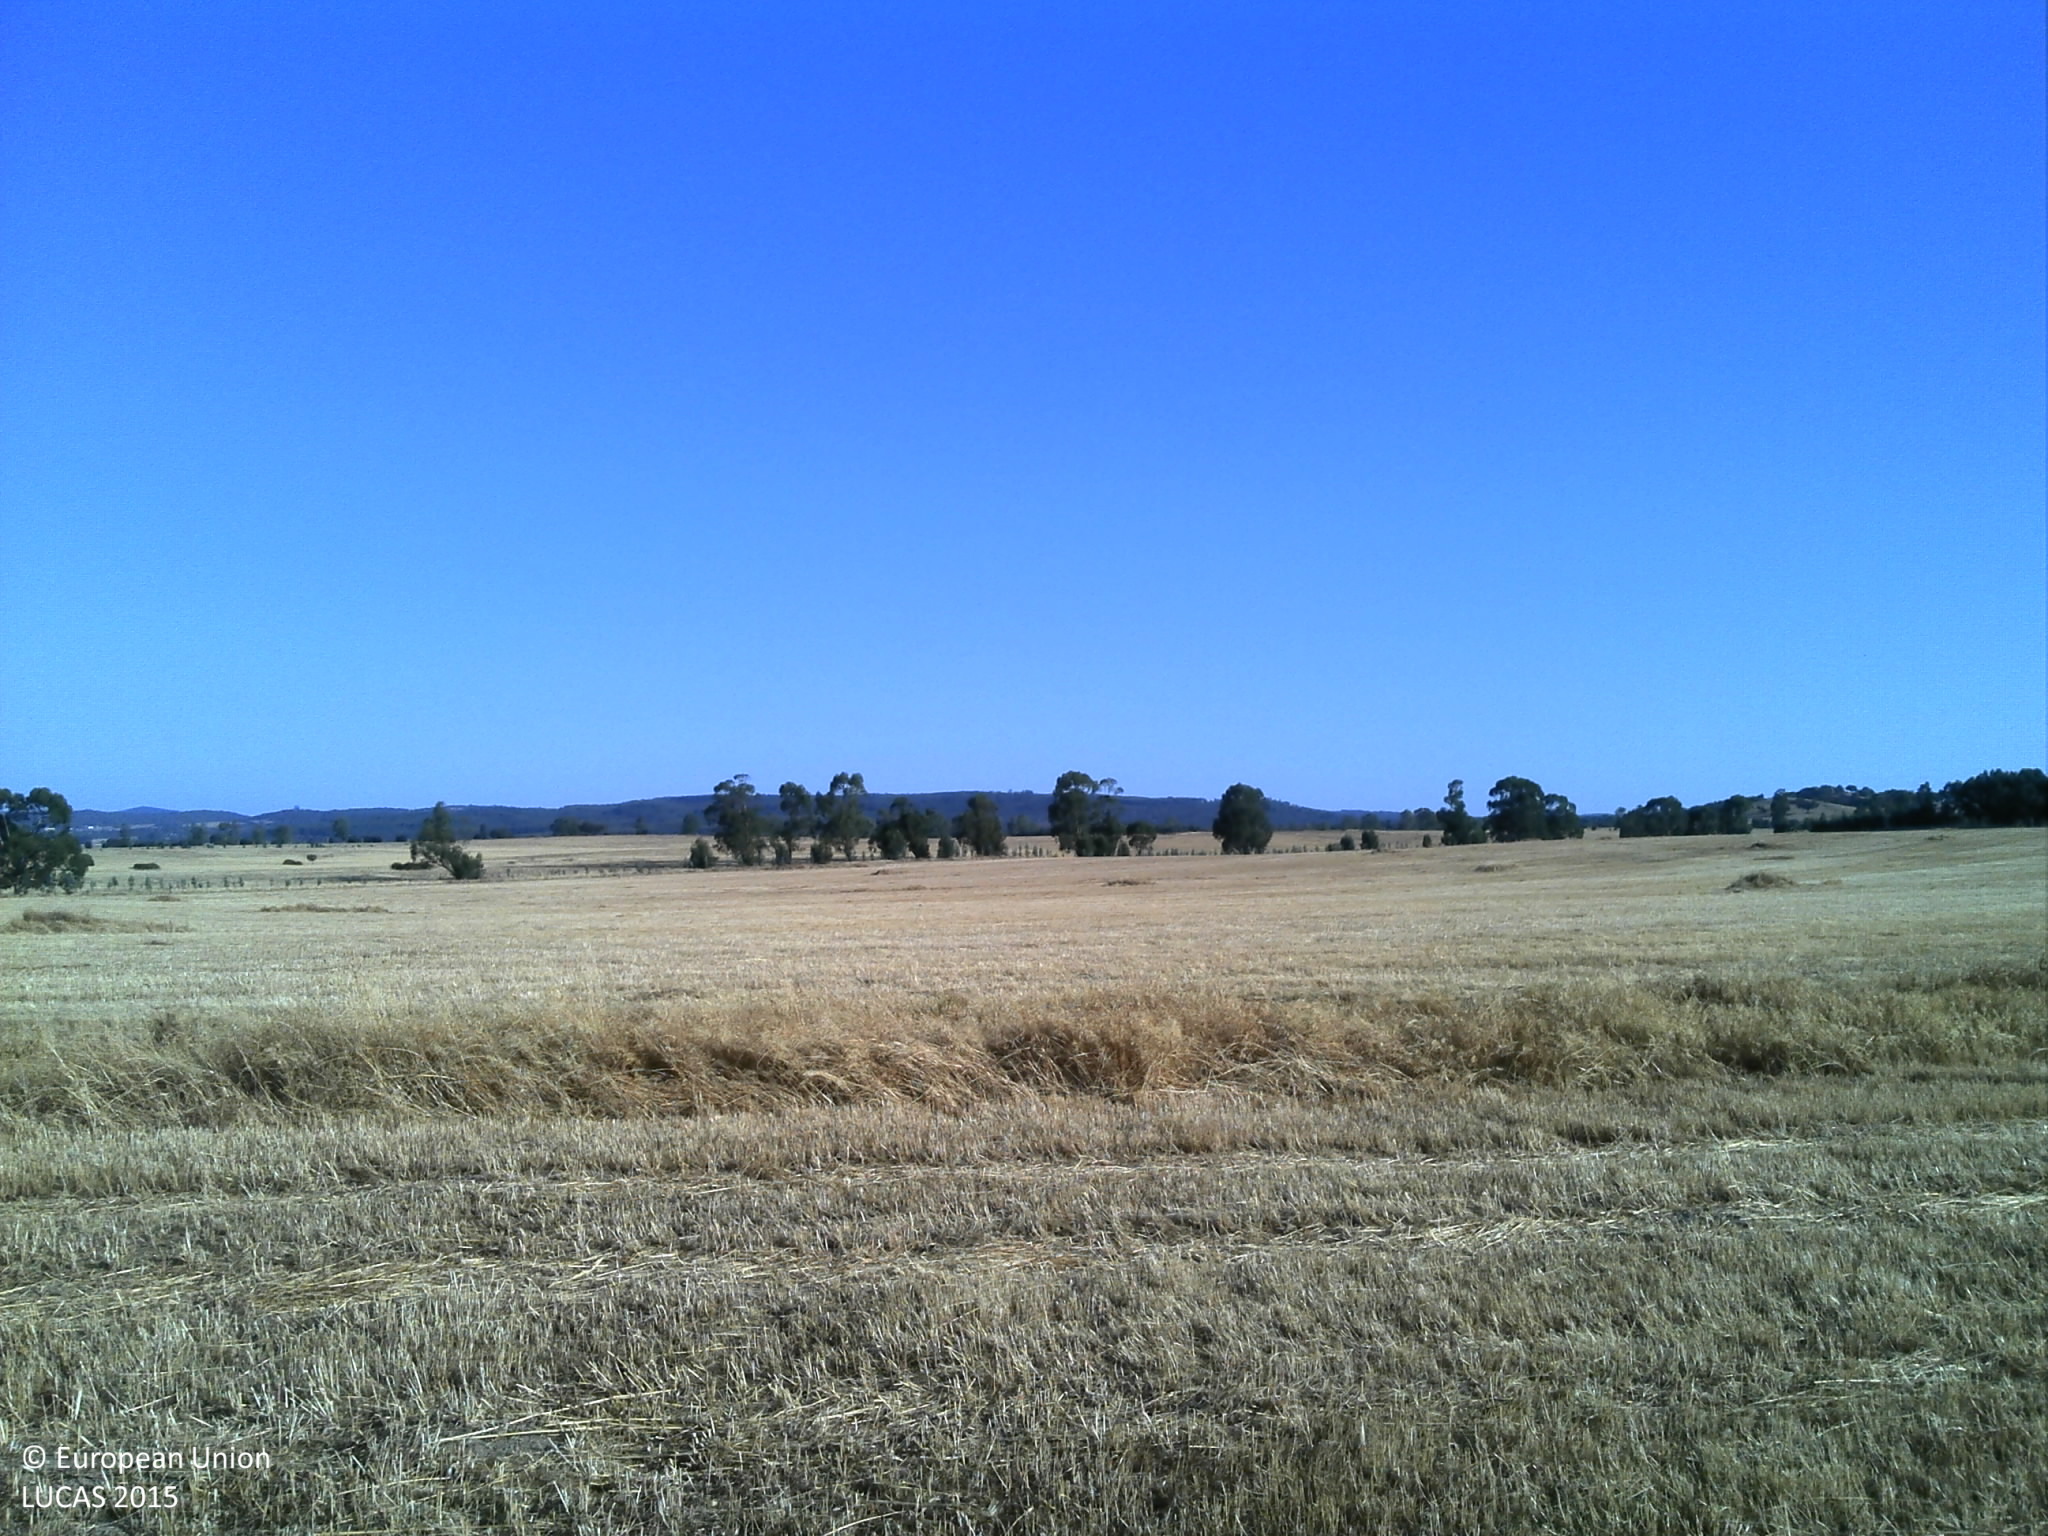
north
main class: Cropland
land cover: Oats
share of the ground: > 75 %
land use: Agriculture (excluding fallow land and kitchen gardens)
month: June
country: PT
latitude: 38.4933
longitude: -8.0065
